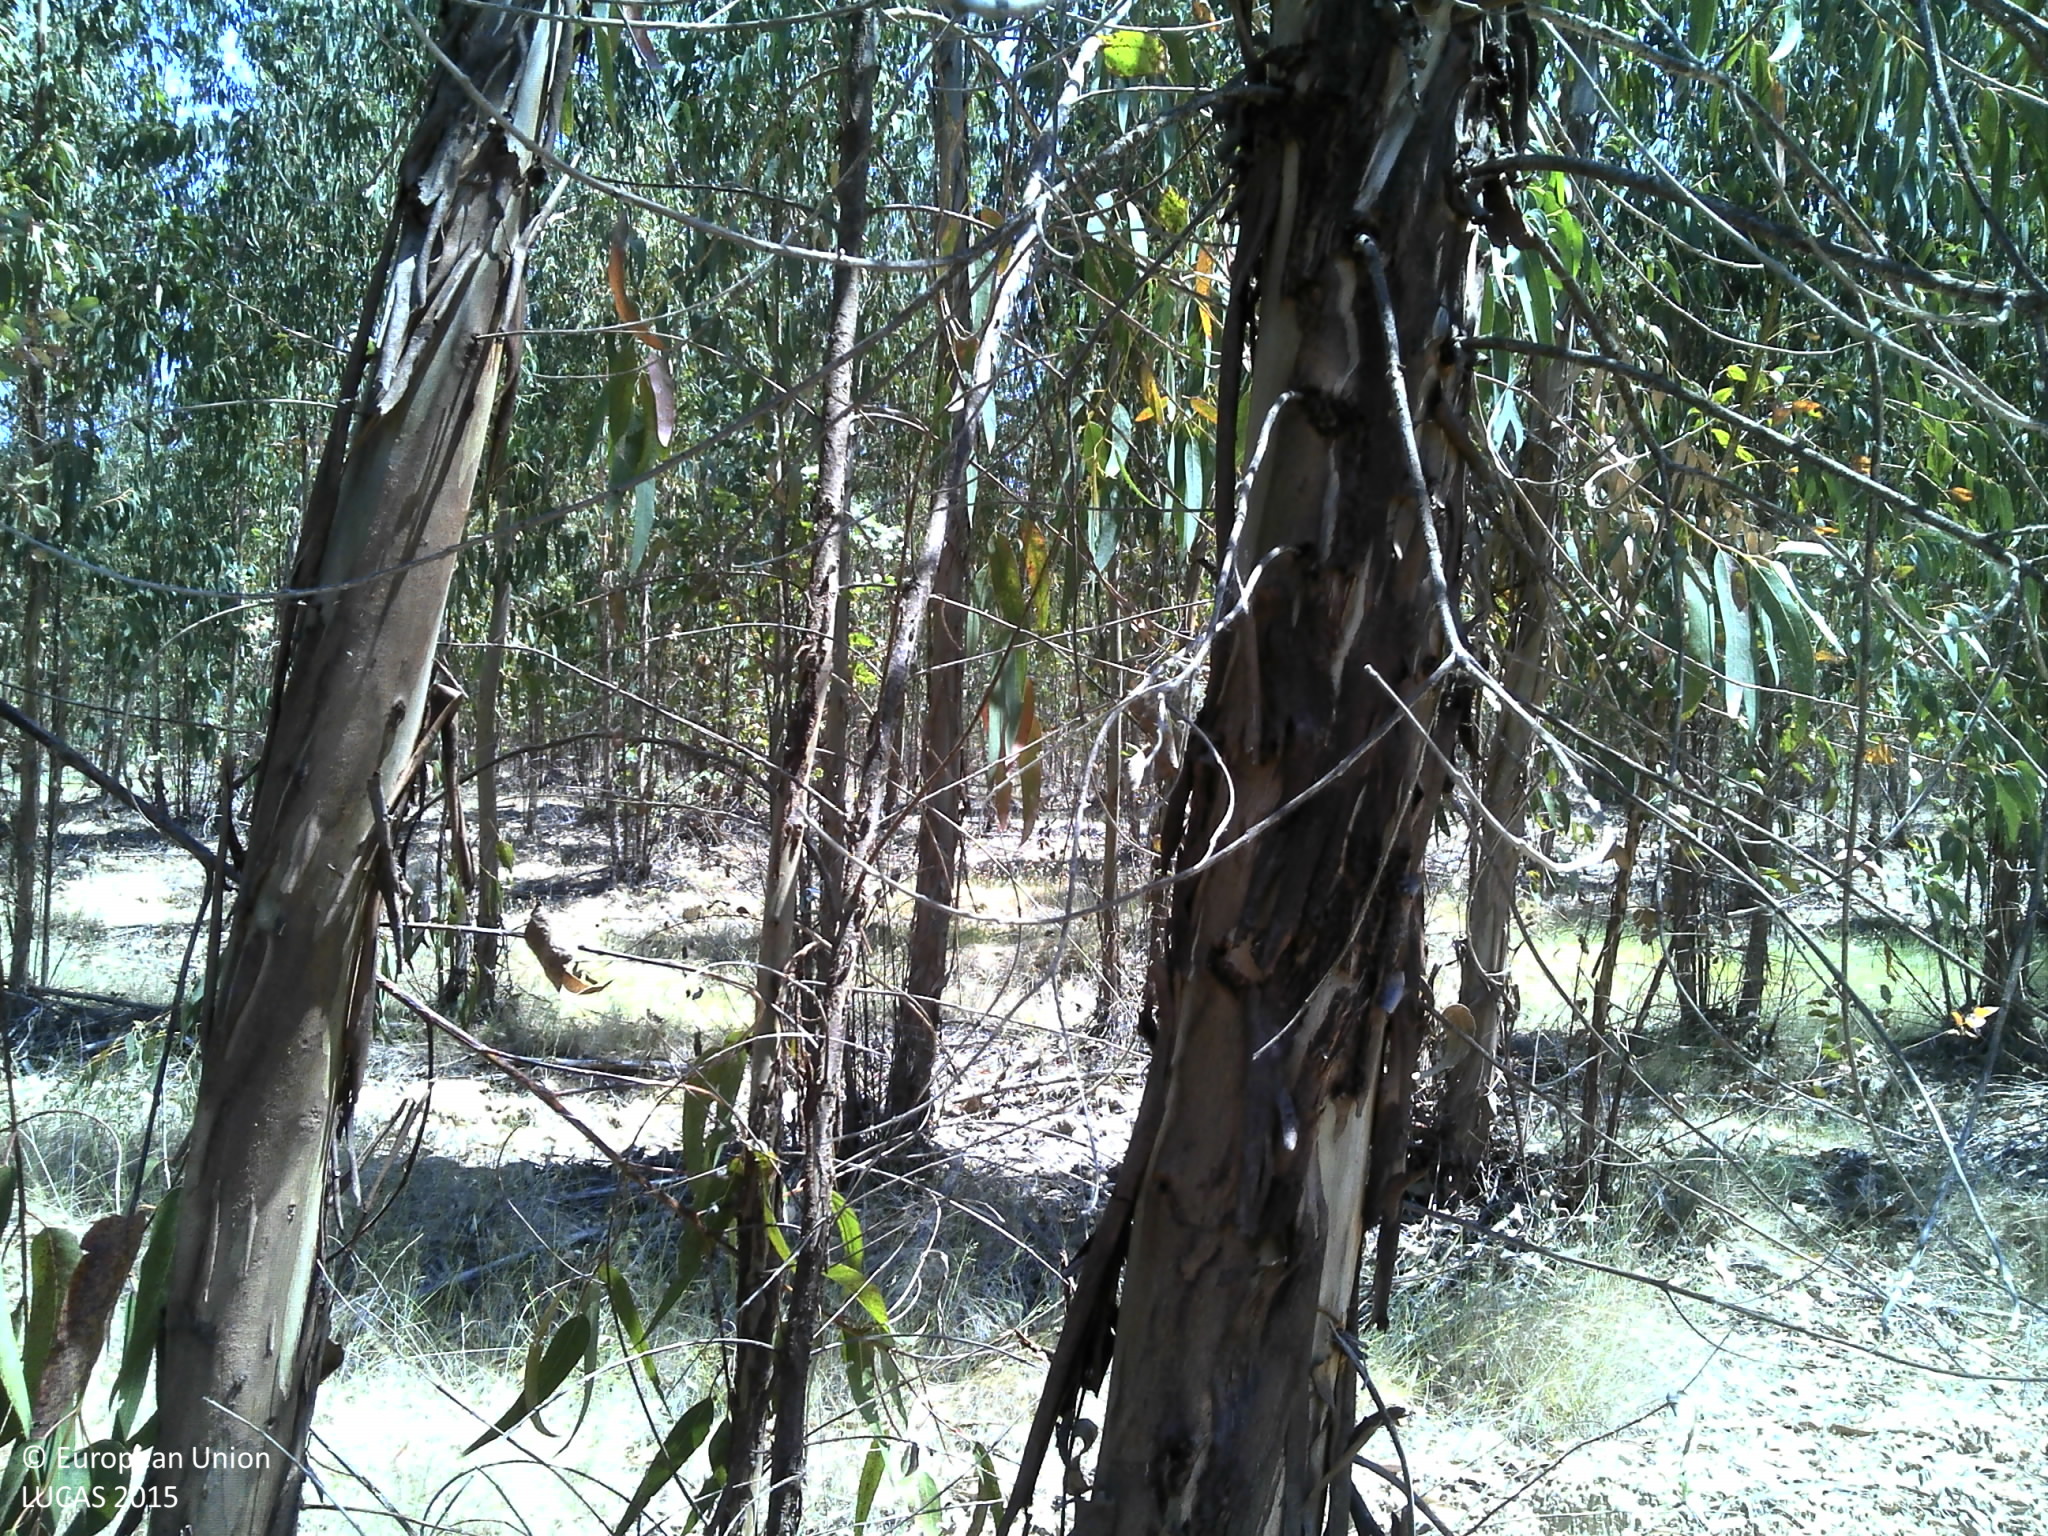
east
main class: Woodland
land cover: Broadleaved woodland
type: exotic forest
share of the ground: 50 - 75 %
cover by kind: broadleaved forest trees 50 %, unconsolidated bare surface 40 %, herbaceous plants 10 %
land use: Forestry
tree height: > 5 m
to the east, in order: Broadleaved woodland; Other bare soil; Broadleaved woodland; Grassland without tree/shrub cover; Tracks; Grassland without tree/shrub cover; Broadleaved woodland
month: May
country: PT
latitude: 39.2580
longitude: -7.6733
